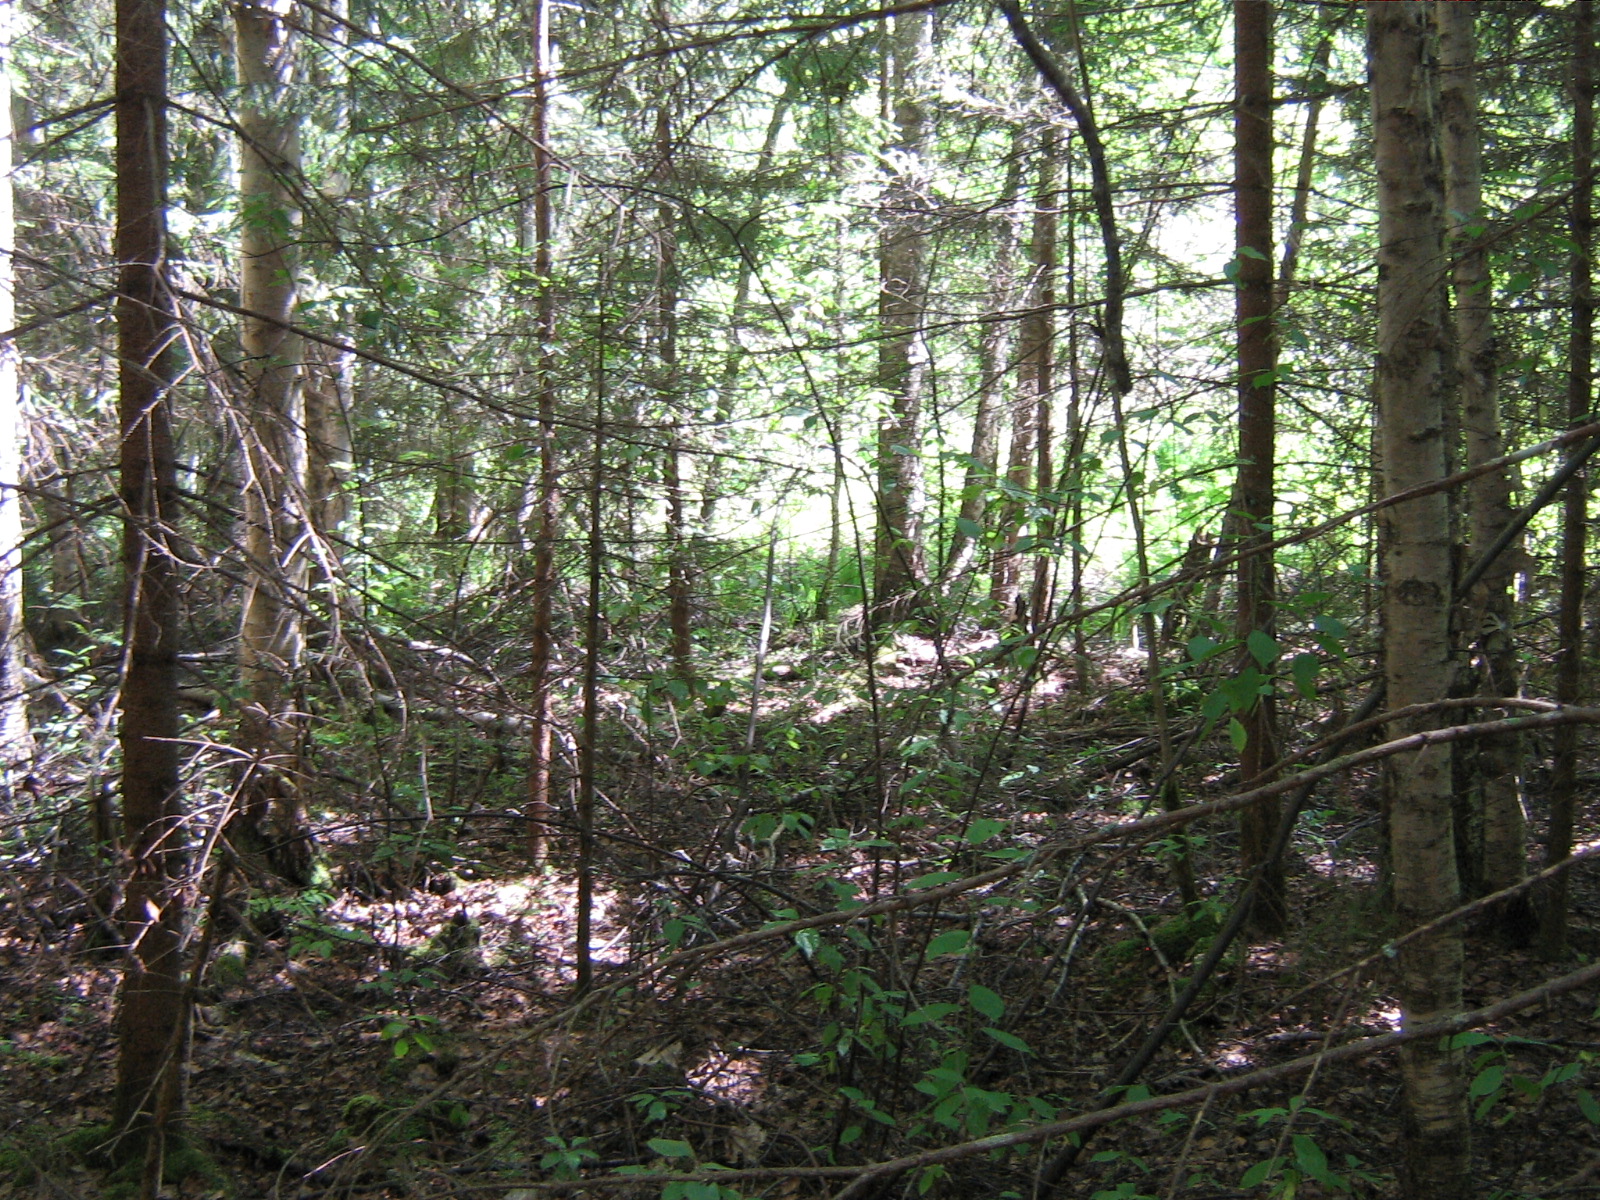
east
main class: Woodland
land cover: Other mixed woodland
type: hemiboreal forest and nemoral coniferous forest and mixed broadleaved-coniferous forest
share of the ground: > 75 %
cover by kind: broadleaved forest trees 65 %, coniferous forest trees 35 %
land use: Forestry
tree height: > 5 m
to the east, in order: Other mixed woodland; Spruce dominated mixed woodland; Spruce dominated coniferous woodland
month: June
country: LV
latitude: 57.0856
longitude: 25.8517
